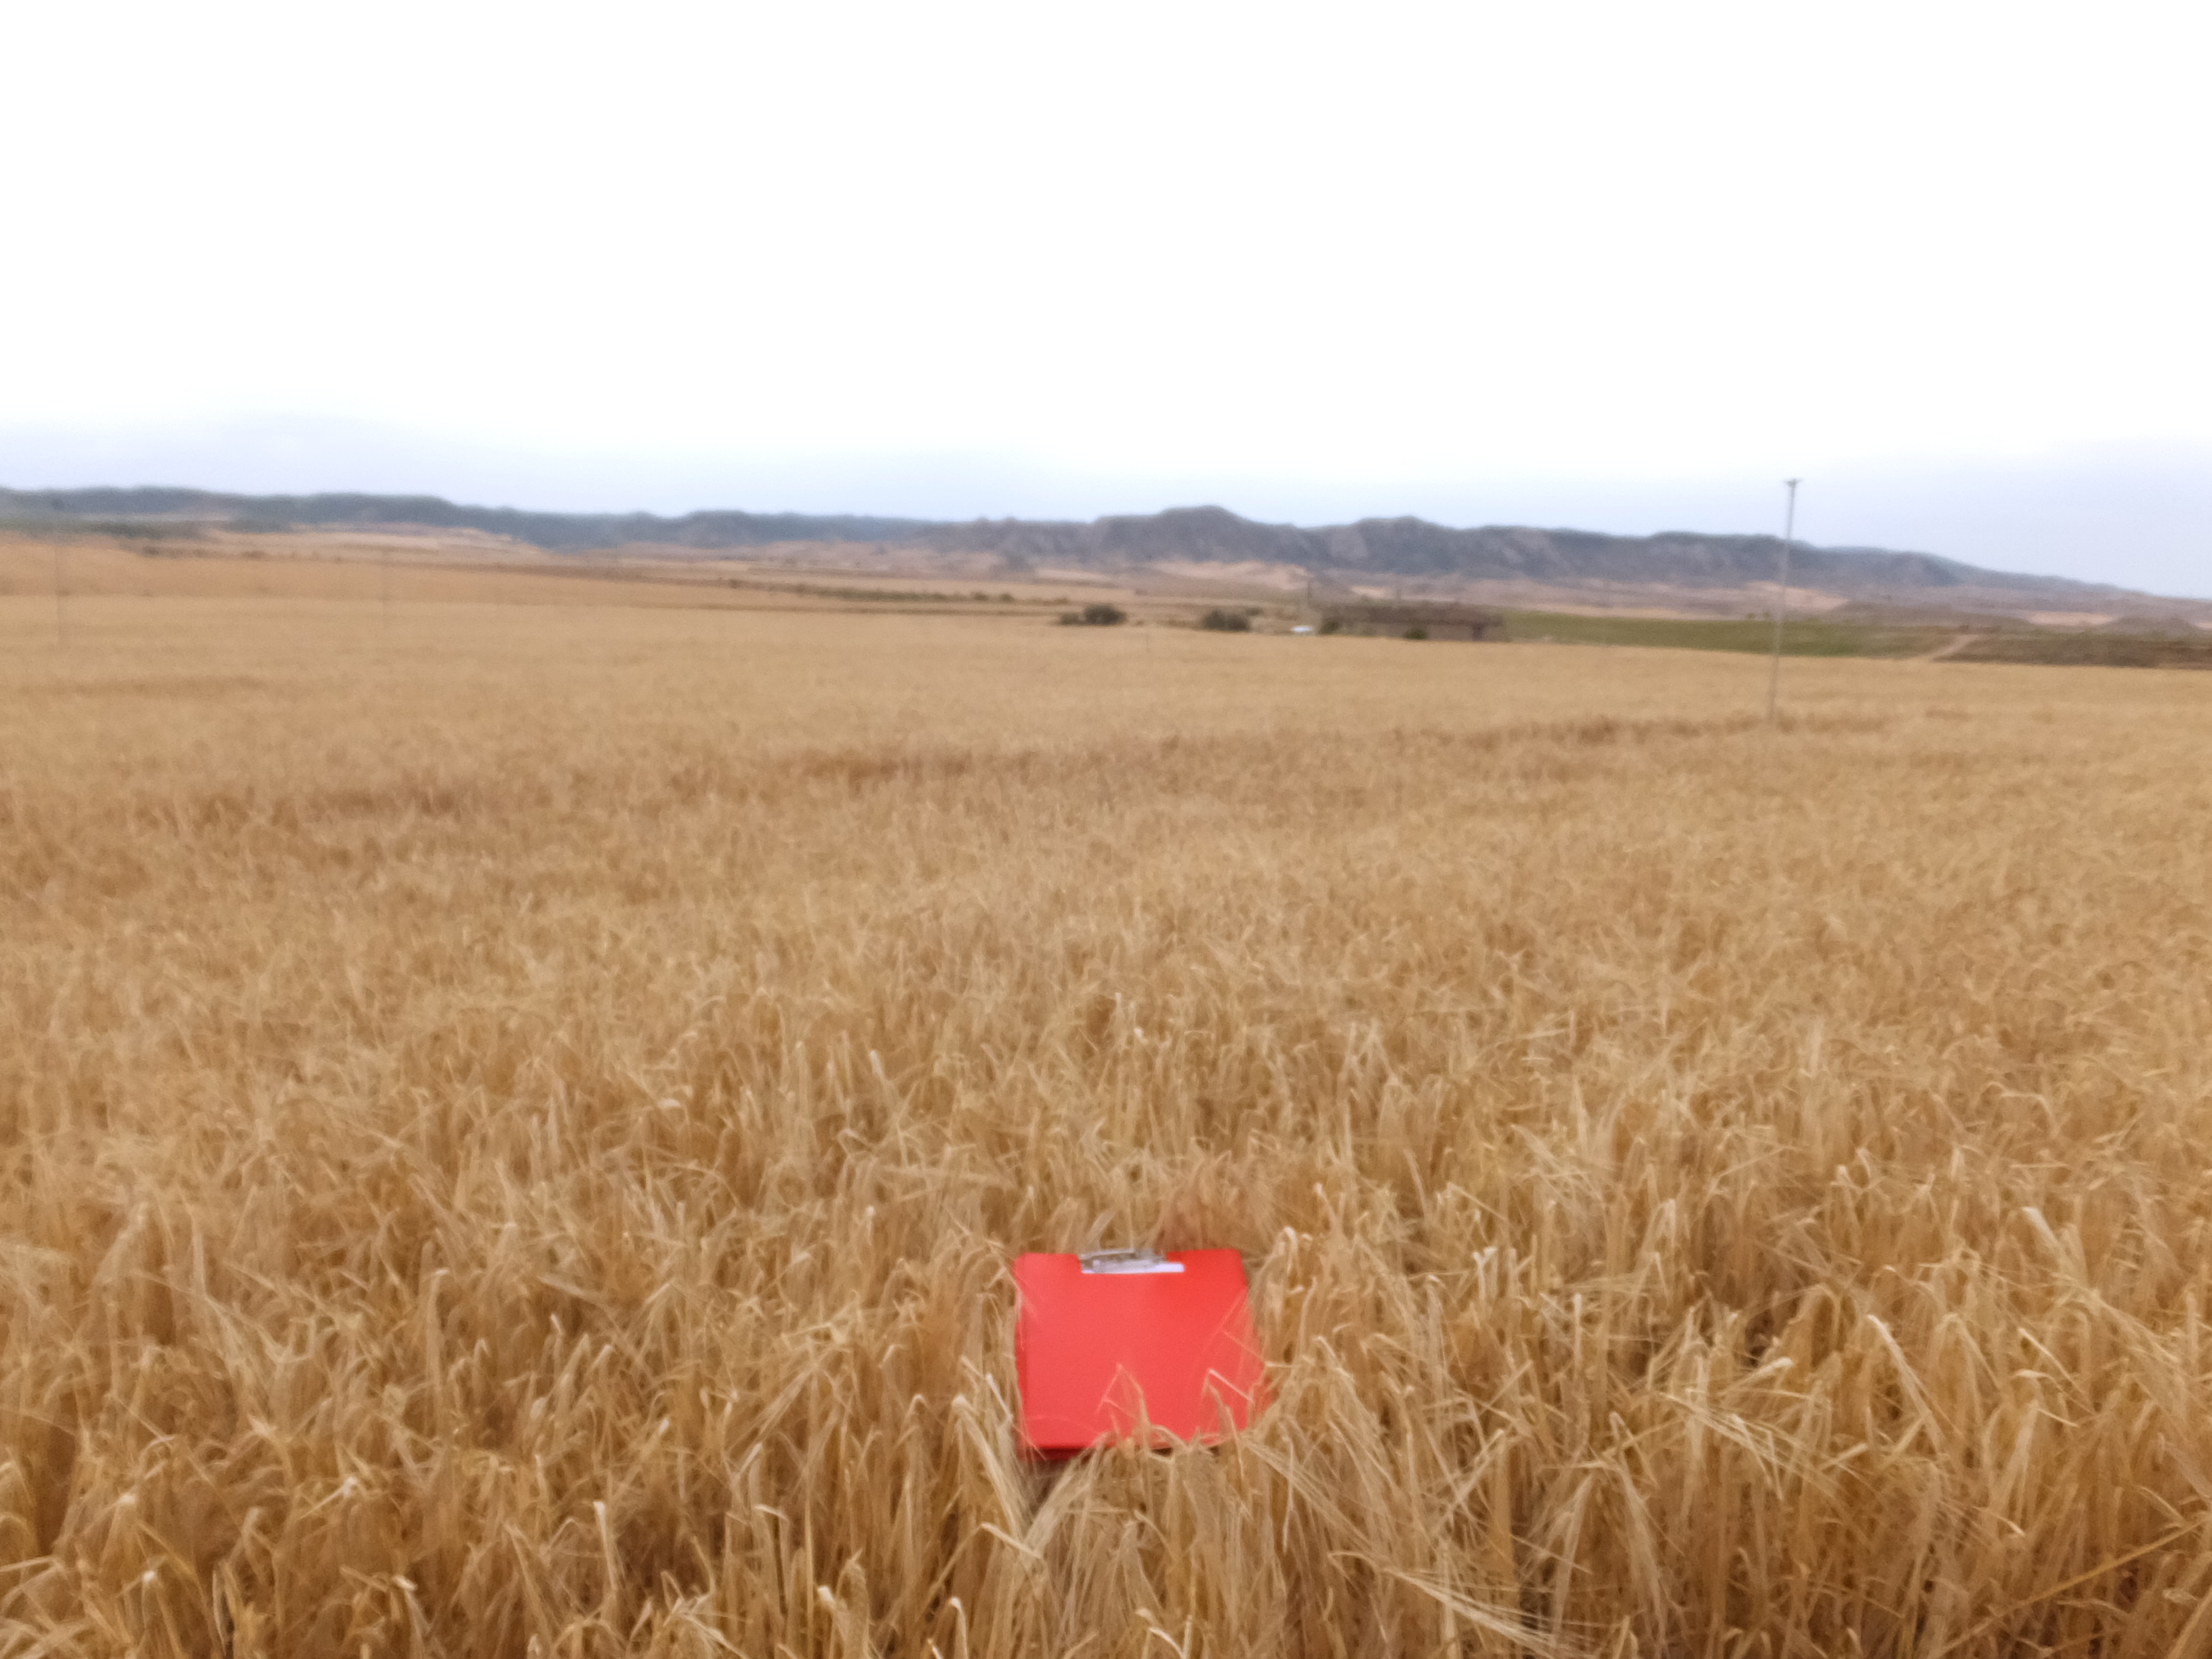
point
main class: Cropland
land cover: Barley
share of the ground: > 75 %
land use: Agriculture (excluding fallow land and kitchen gardens)
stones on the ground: < 10 %
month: June
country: ES
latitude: 41.6541
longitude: 0.0538
